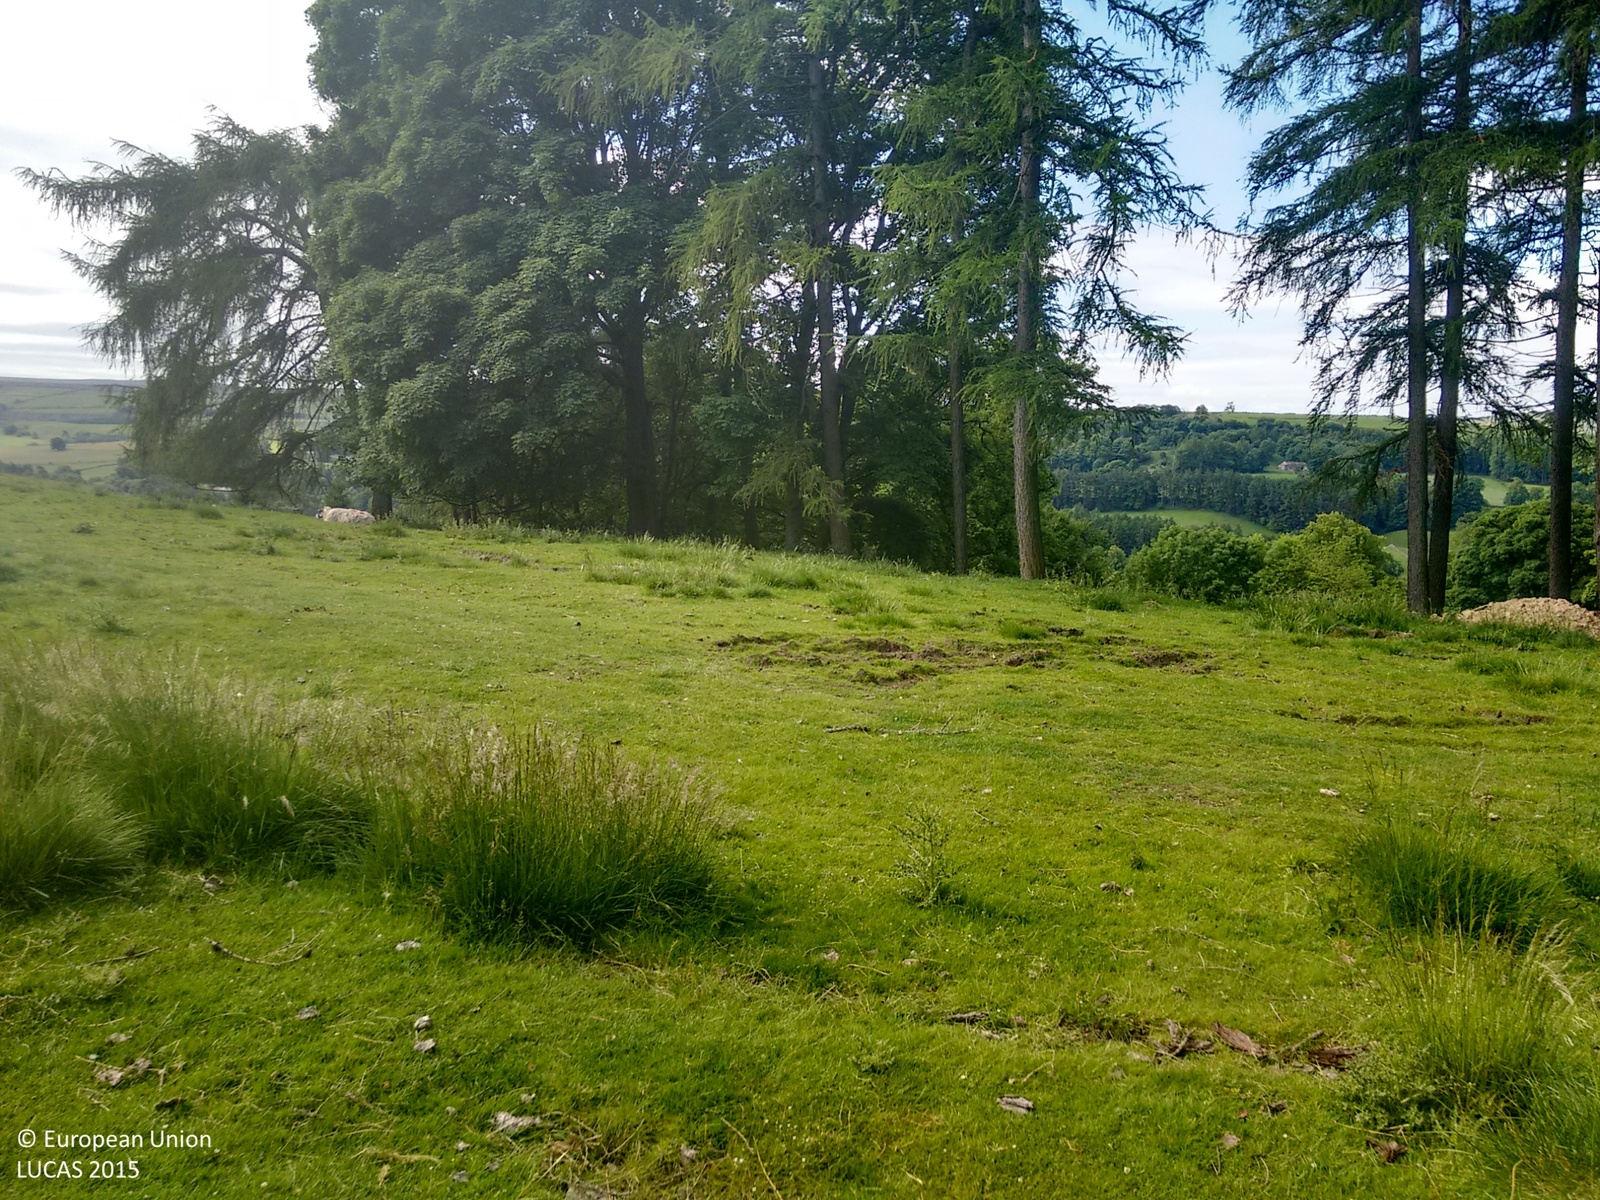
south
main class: Grassland
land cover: Grassland without tree/shrub cover
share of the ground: > 75 %
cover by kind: herbaceous plants 100 %
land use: Agriculture (excluding fallow land and kitchen gardens)
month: June
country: GB
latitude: 54.7486
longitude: -2.0023
